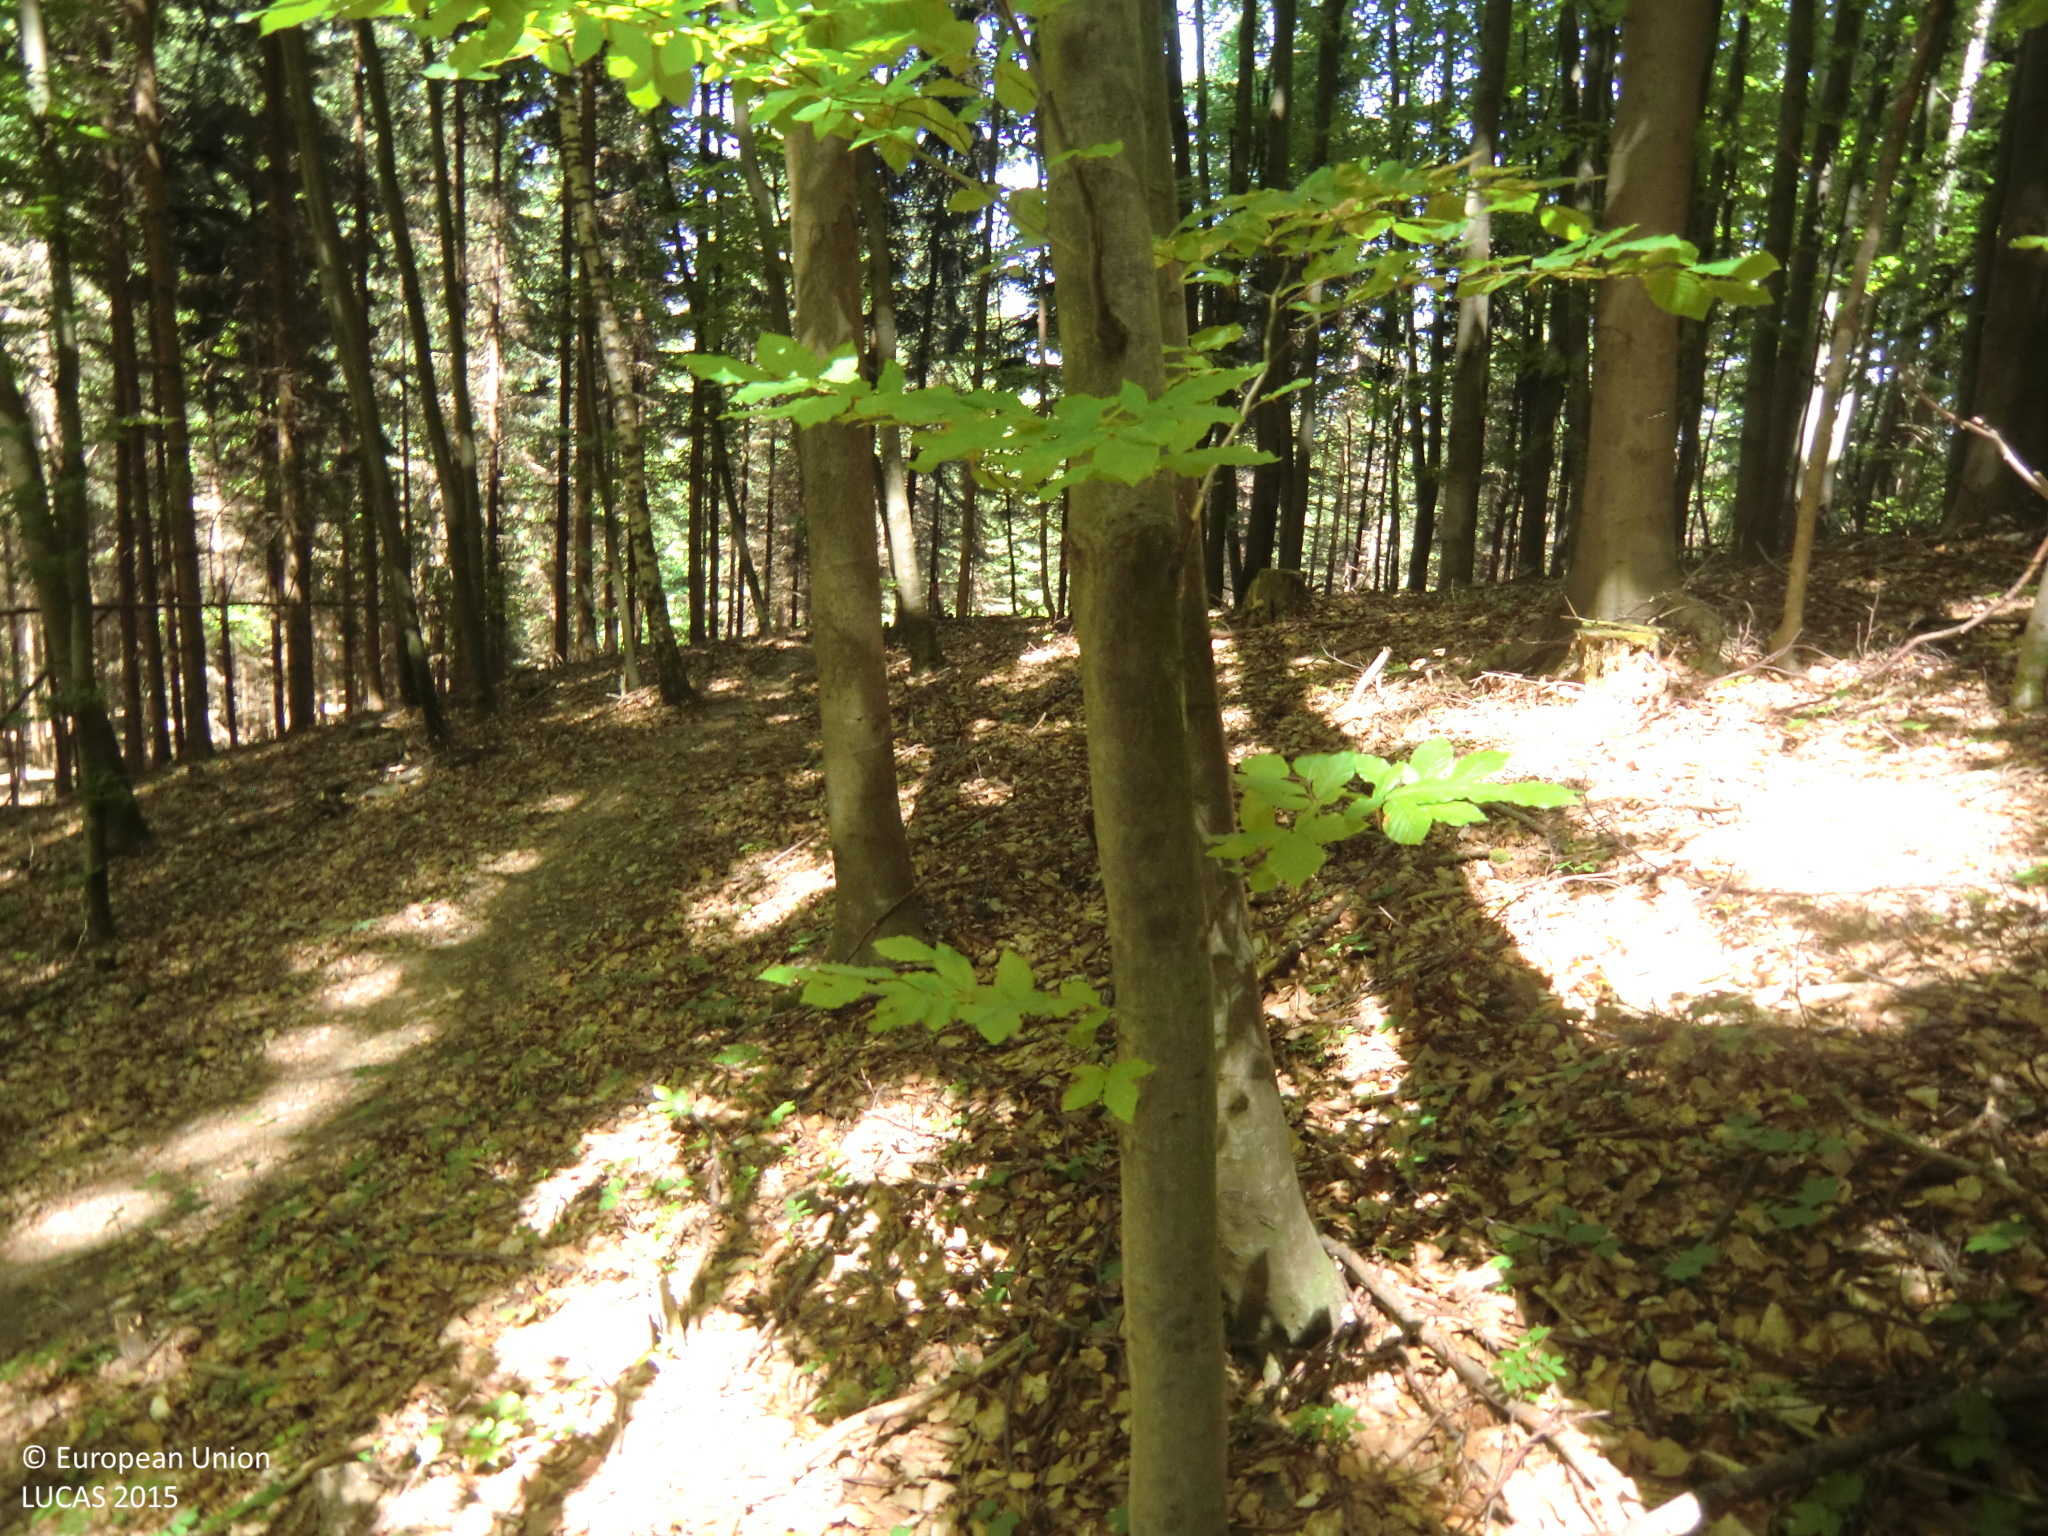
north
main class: Woodland
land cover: Broadleaved woodland
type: beech forest
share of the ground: > 75 %
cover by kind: broadleaved forest trees 80 %, coniferous forest trees 10 %, unconsolidated bare surface 10 %
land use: Forestry
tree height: > 5 m
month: May
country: AT
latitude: 48.0600
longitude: 15.3017
